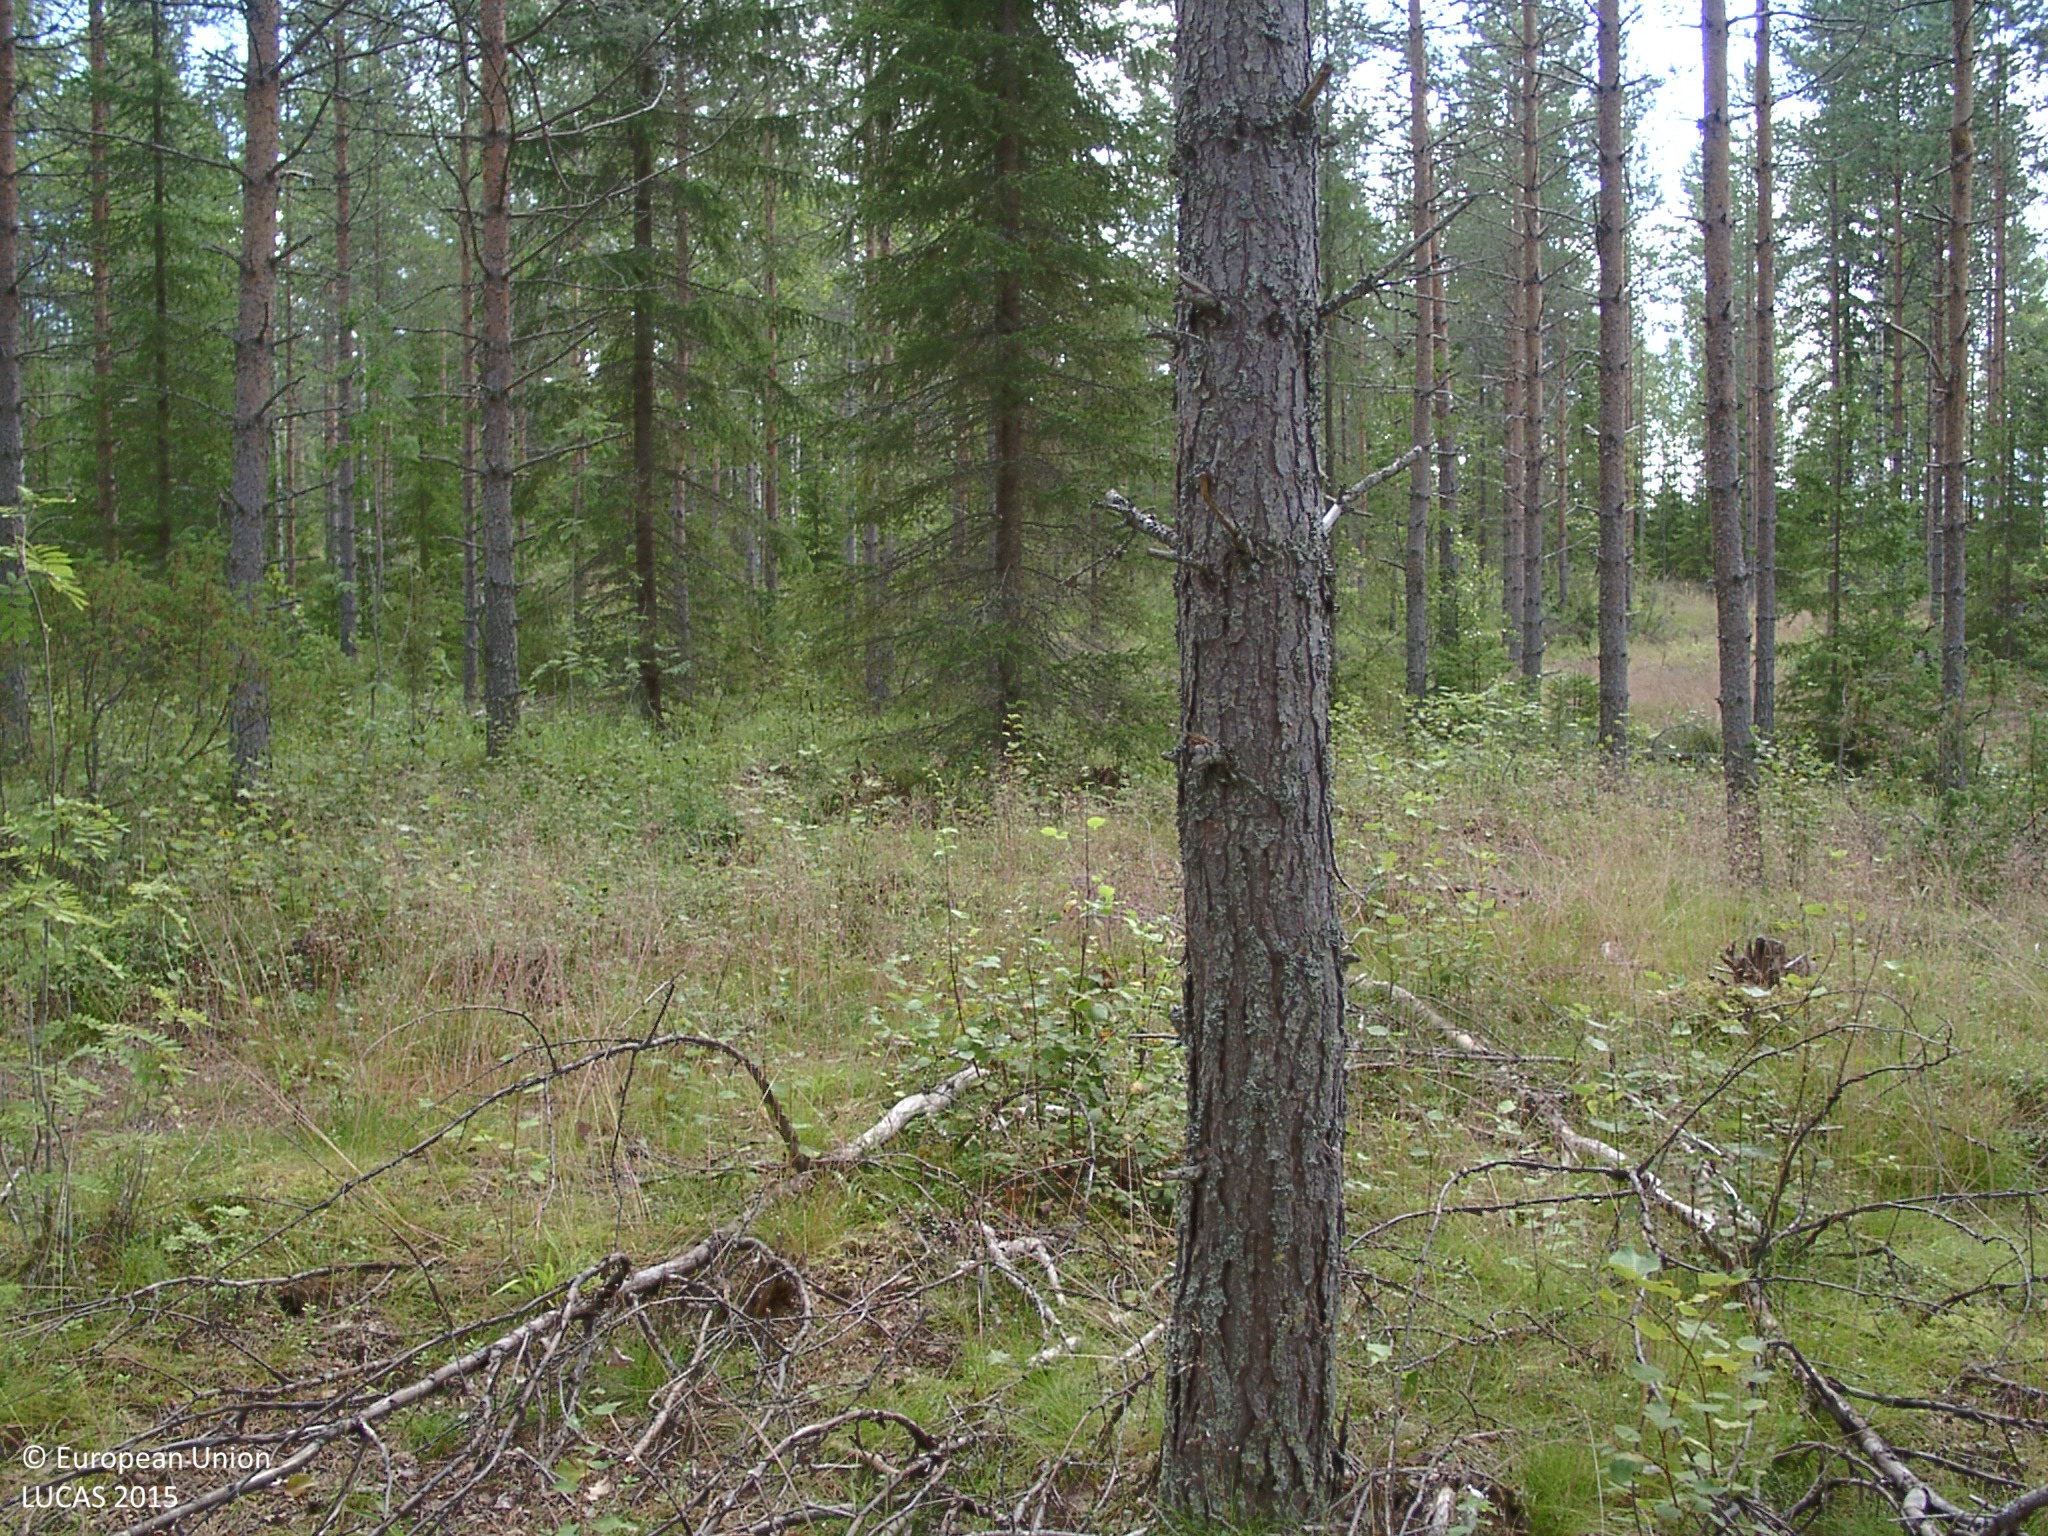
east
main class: Woodland
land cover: Pine dominated coniferous woodland
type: boreal forest
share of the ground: 50 - 75 %
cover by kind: coniferous forest trees 60 %, shrubs 10 %, herbaceous plants 10 %, lichens and mosses 10 %, broadleaved forest trees 5 %
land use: Forestry
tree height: > 5 m
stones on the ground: < 10 %
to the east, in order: Pine dominated coniferous woodland; Shruby margins; Other coniferous woodland; Grass margins; Other coniferous woodland; Grass margins; Spruce dominated mixed woodland; Grass margins; Other coniferous woodland; Groves; Tracks; Groves; Ditches and canals; Other coniferous woodland; Spruce dominated coniferous woodland
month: August
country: FI
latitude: 62.3331
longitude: 25.5389
